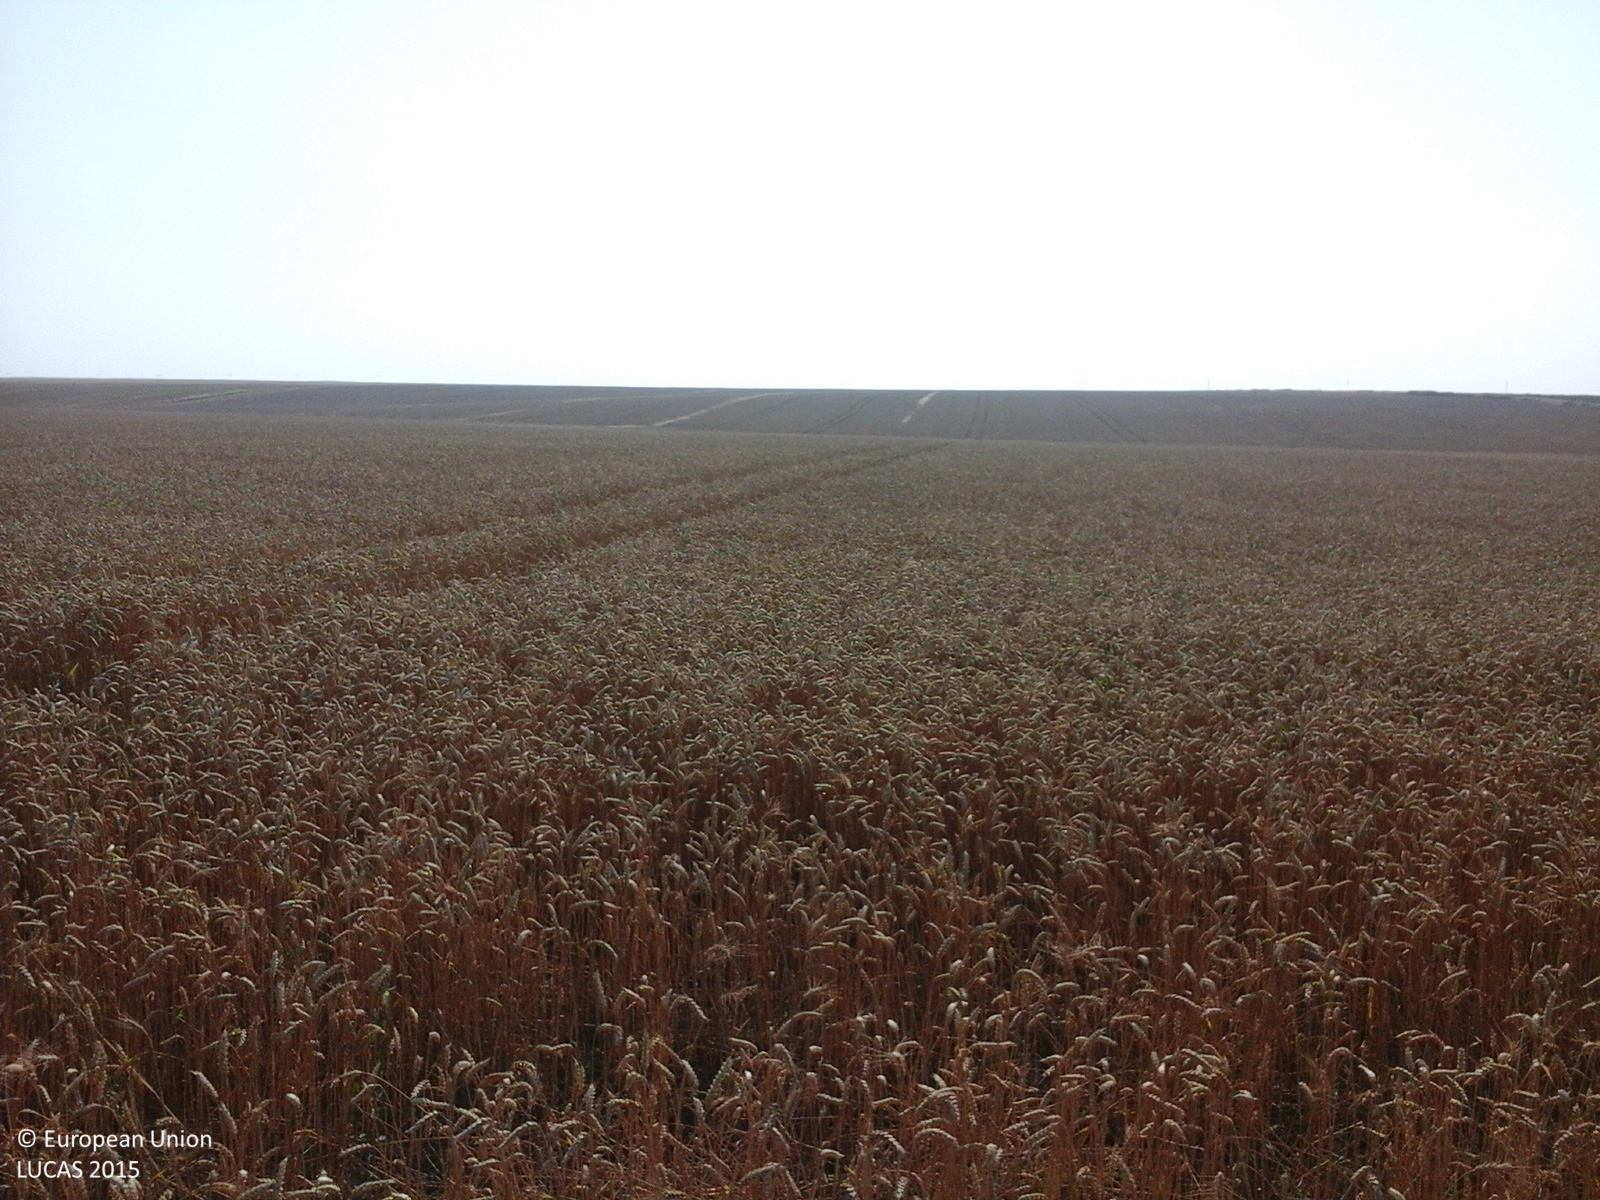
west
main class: Cropland
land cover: Common wheat
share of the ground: > 75 %
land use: Agriculture (excluding fallow land and kitchen gardens)
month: July
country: RO
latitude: 44.6245
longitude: 24.5036
